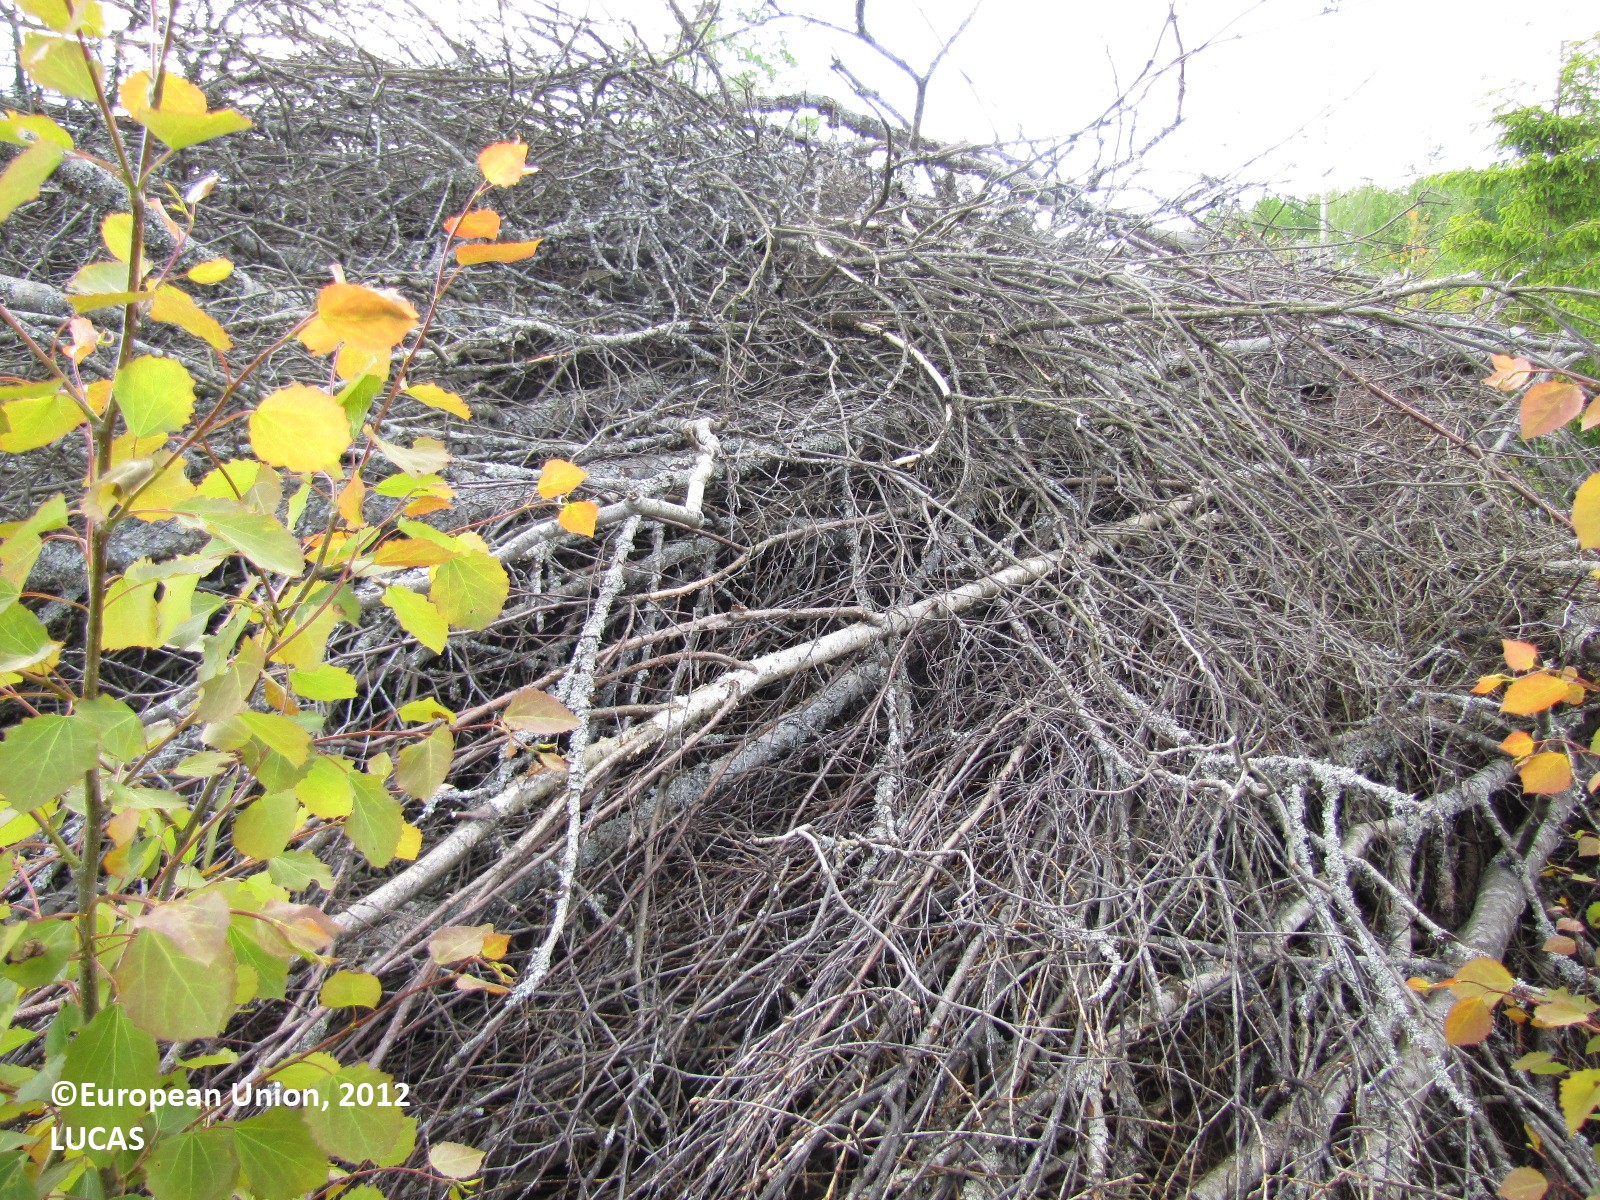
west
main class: Woodland
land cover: Broadleaved woodland
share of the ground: 25 - 50 %
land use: Semi-natural and natural areas not in use
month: June
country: FI
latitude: 61.4213
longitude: 23.0209
